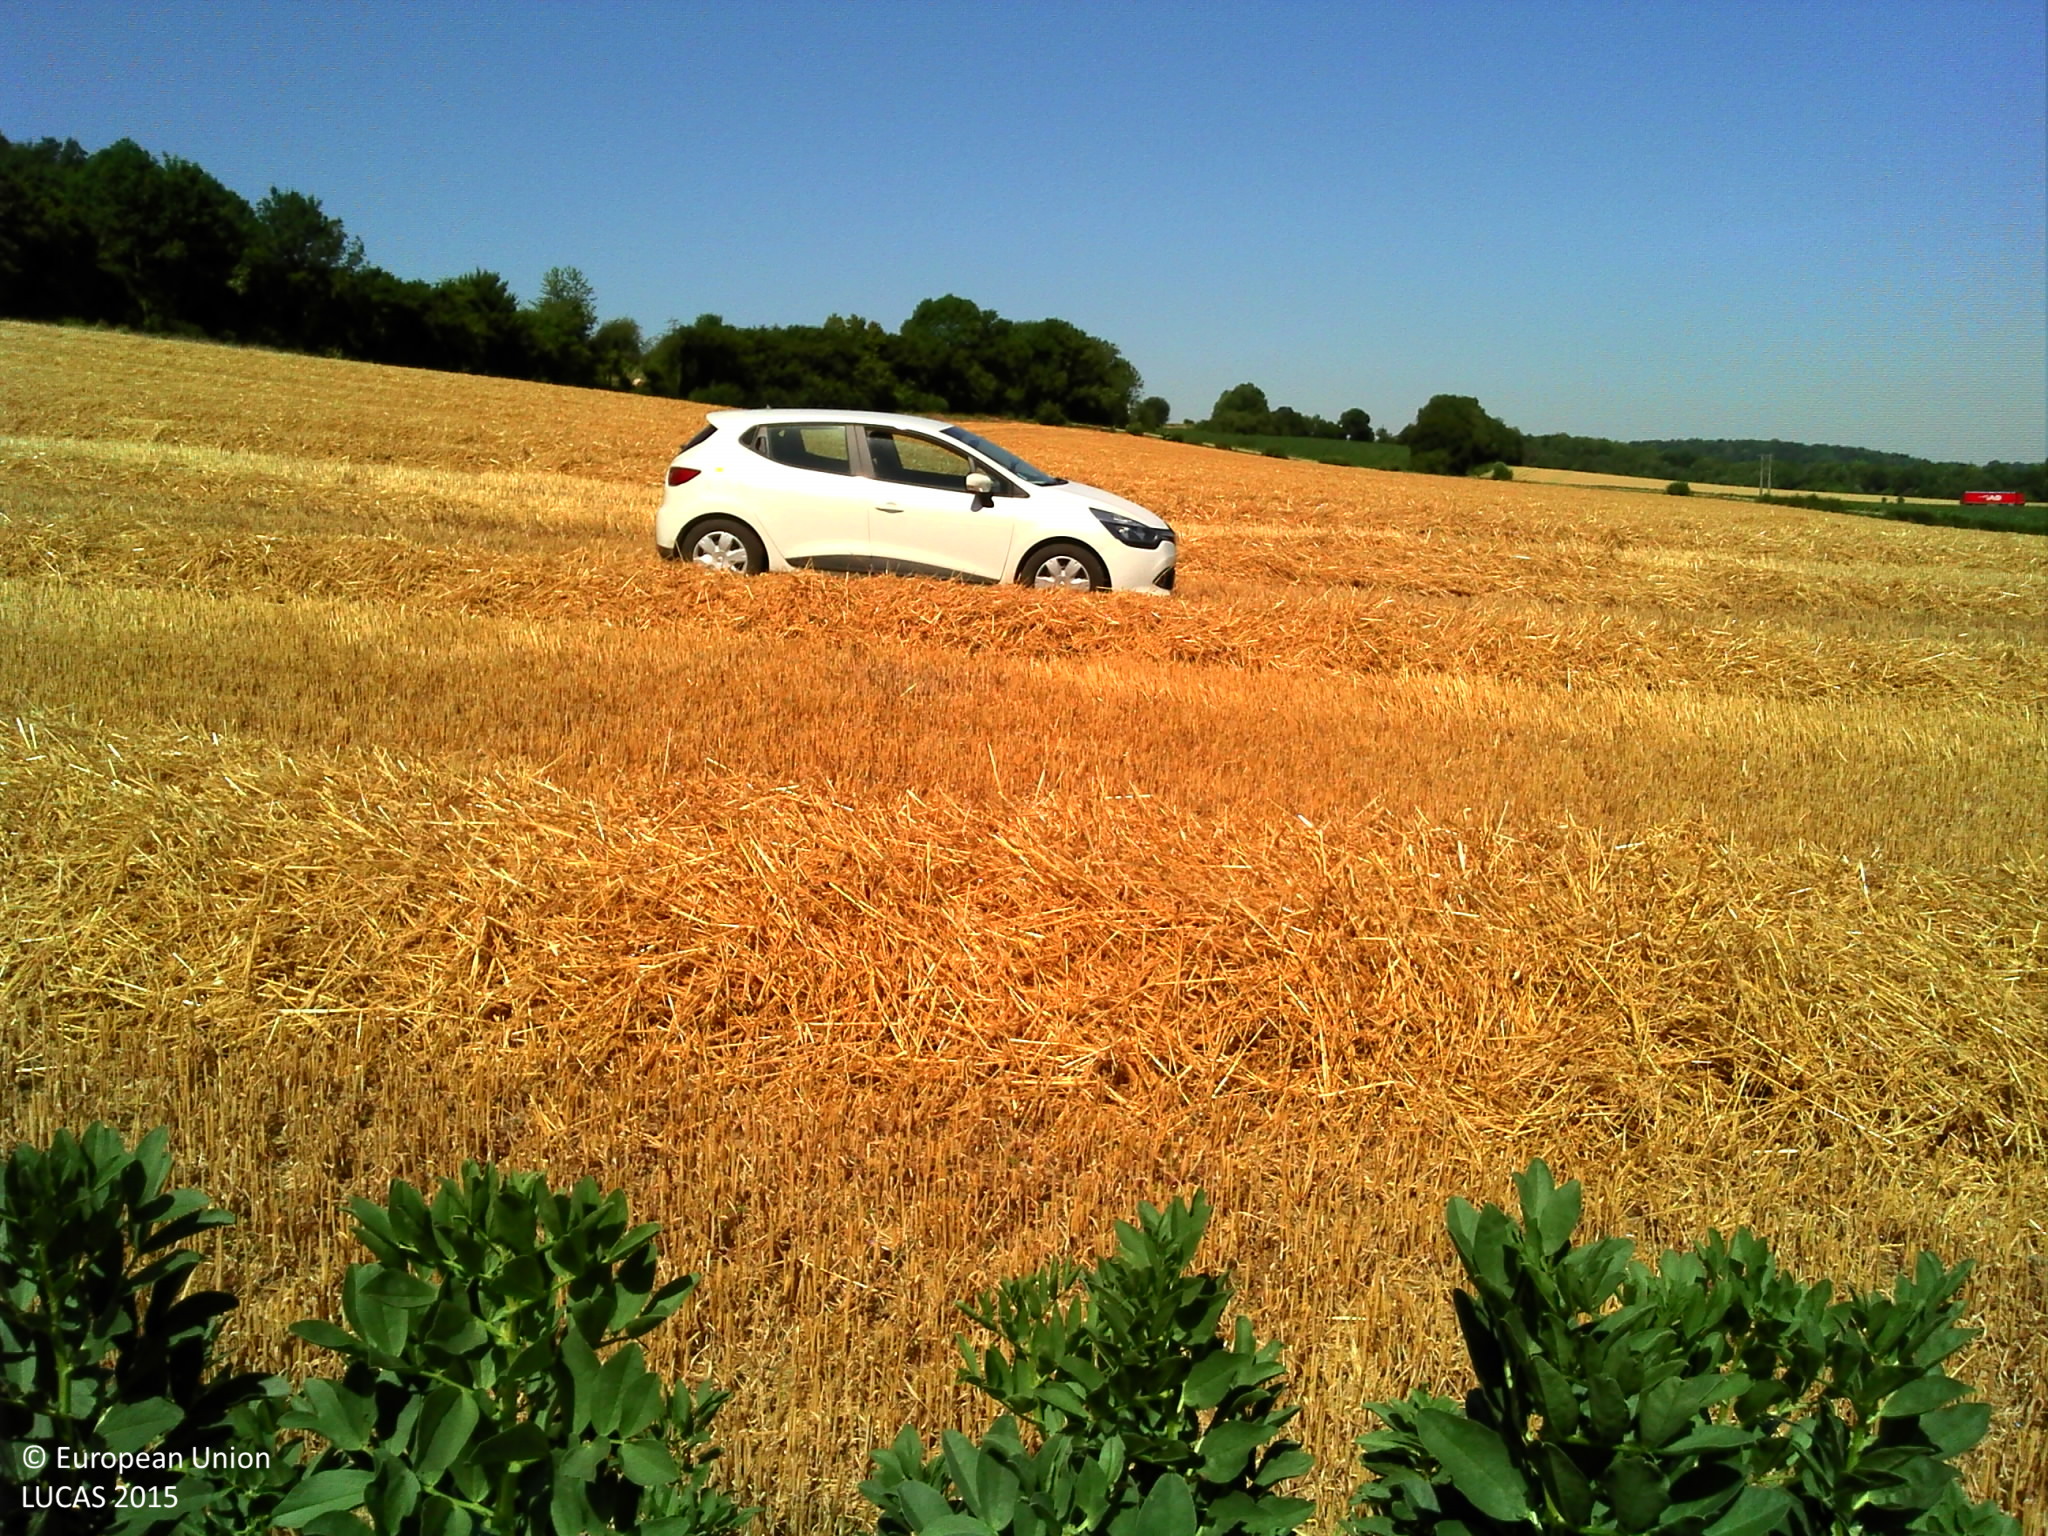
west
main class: Cropland
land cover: Dry pulses
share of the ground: > 75 %
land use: Agriculture (excluding fallow land and kitchen gardens)
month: July
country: FR
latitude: 50.2186
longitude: 2.1228
